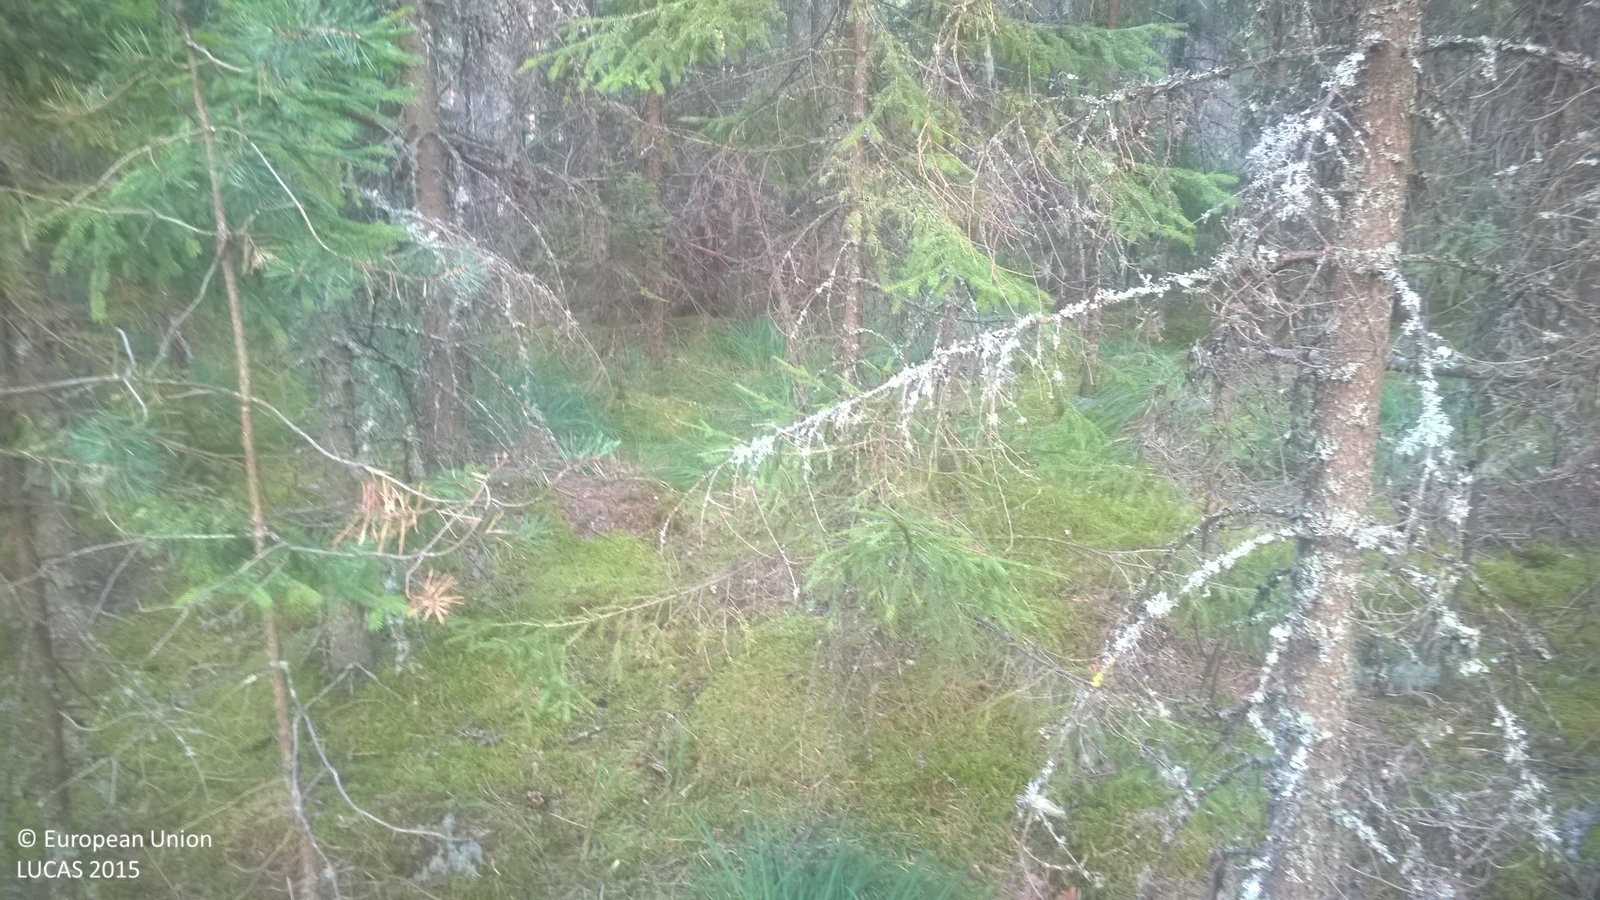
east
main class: Woodland
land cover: Spruce dominated coniferous woodland
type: hemiboreal forest and nemoral coniferous forest and mixed broadleaved-coniferous forest
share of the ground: > 75 %
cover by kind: coniferous forest trees 85 %, lichens and mosses 10 %, unconsolidated bare surface 5 %
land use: Forestry
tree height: > 5 m
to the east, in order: Spruce dominated coniferous woodland; Other coniferous woodland; Pine dominated coniferous woodland
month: August
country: LV
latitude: 57.6523
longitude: 26.0308
